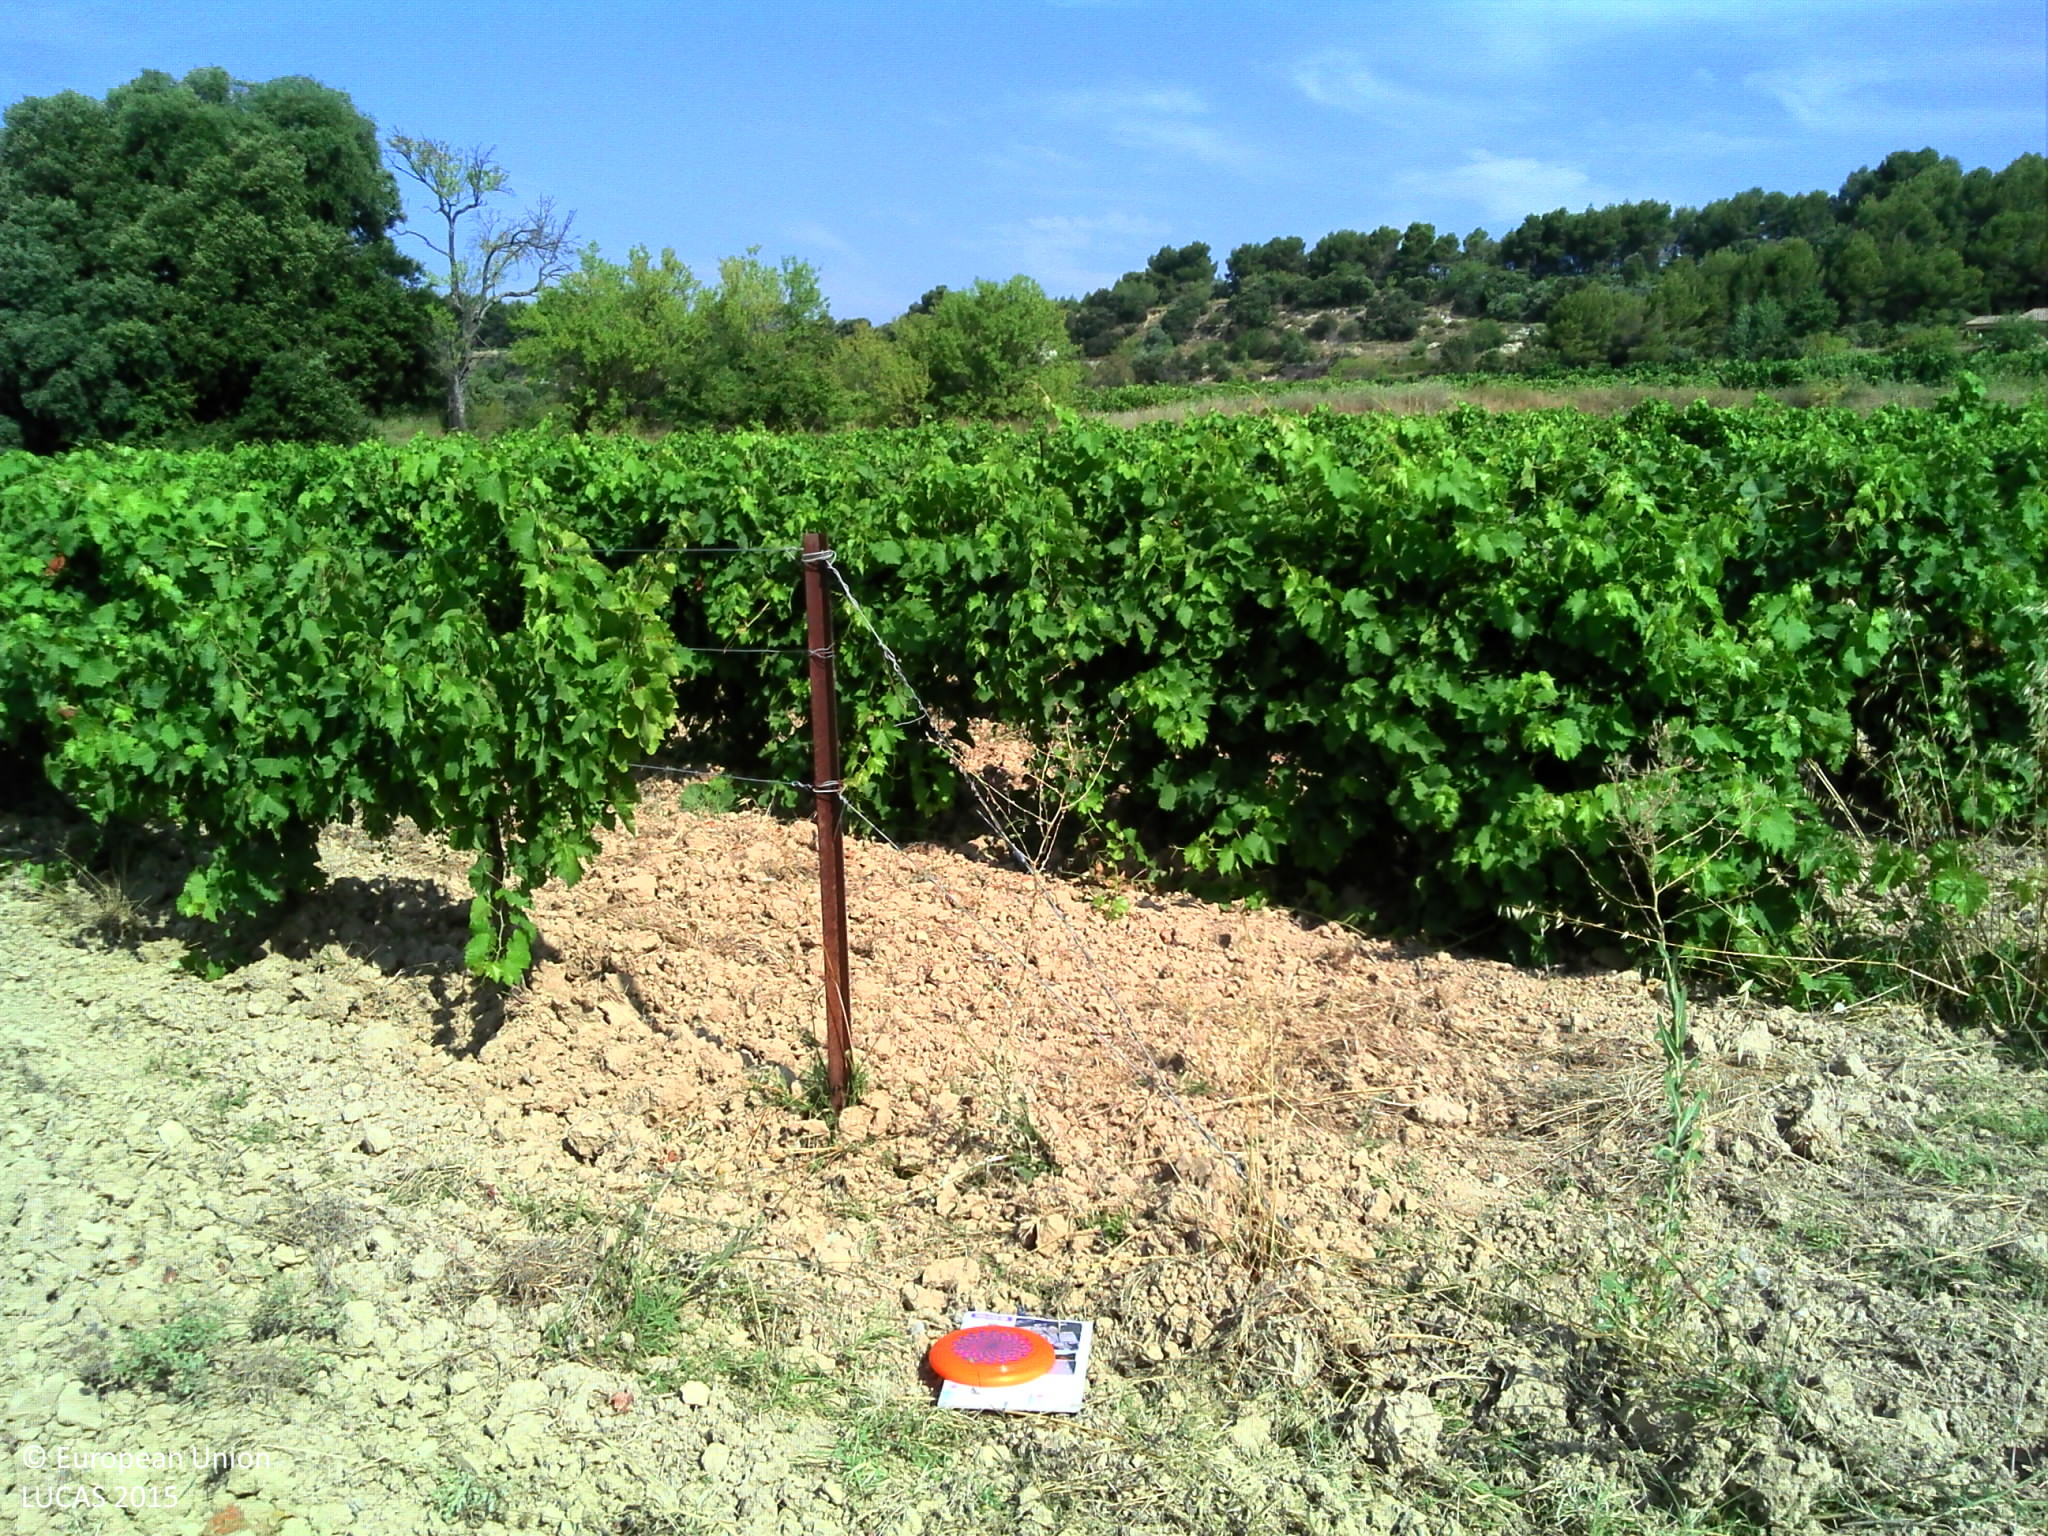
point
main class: Cropland
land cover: Vineyards
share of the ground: 25 - 50 %
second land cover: Other bare soil
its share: > 75 %
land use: Agriculture (excluding fallow land and kitchen gardens)
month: July
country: FR
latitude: 43.6953
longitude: 5.5548
